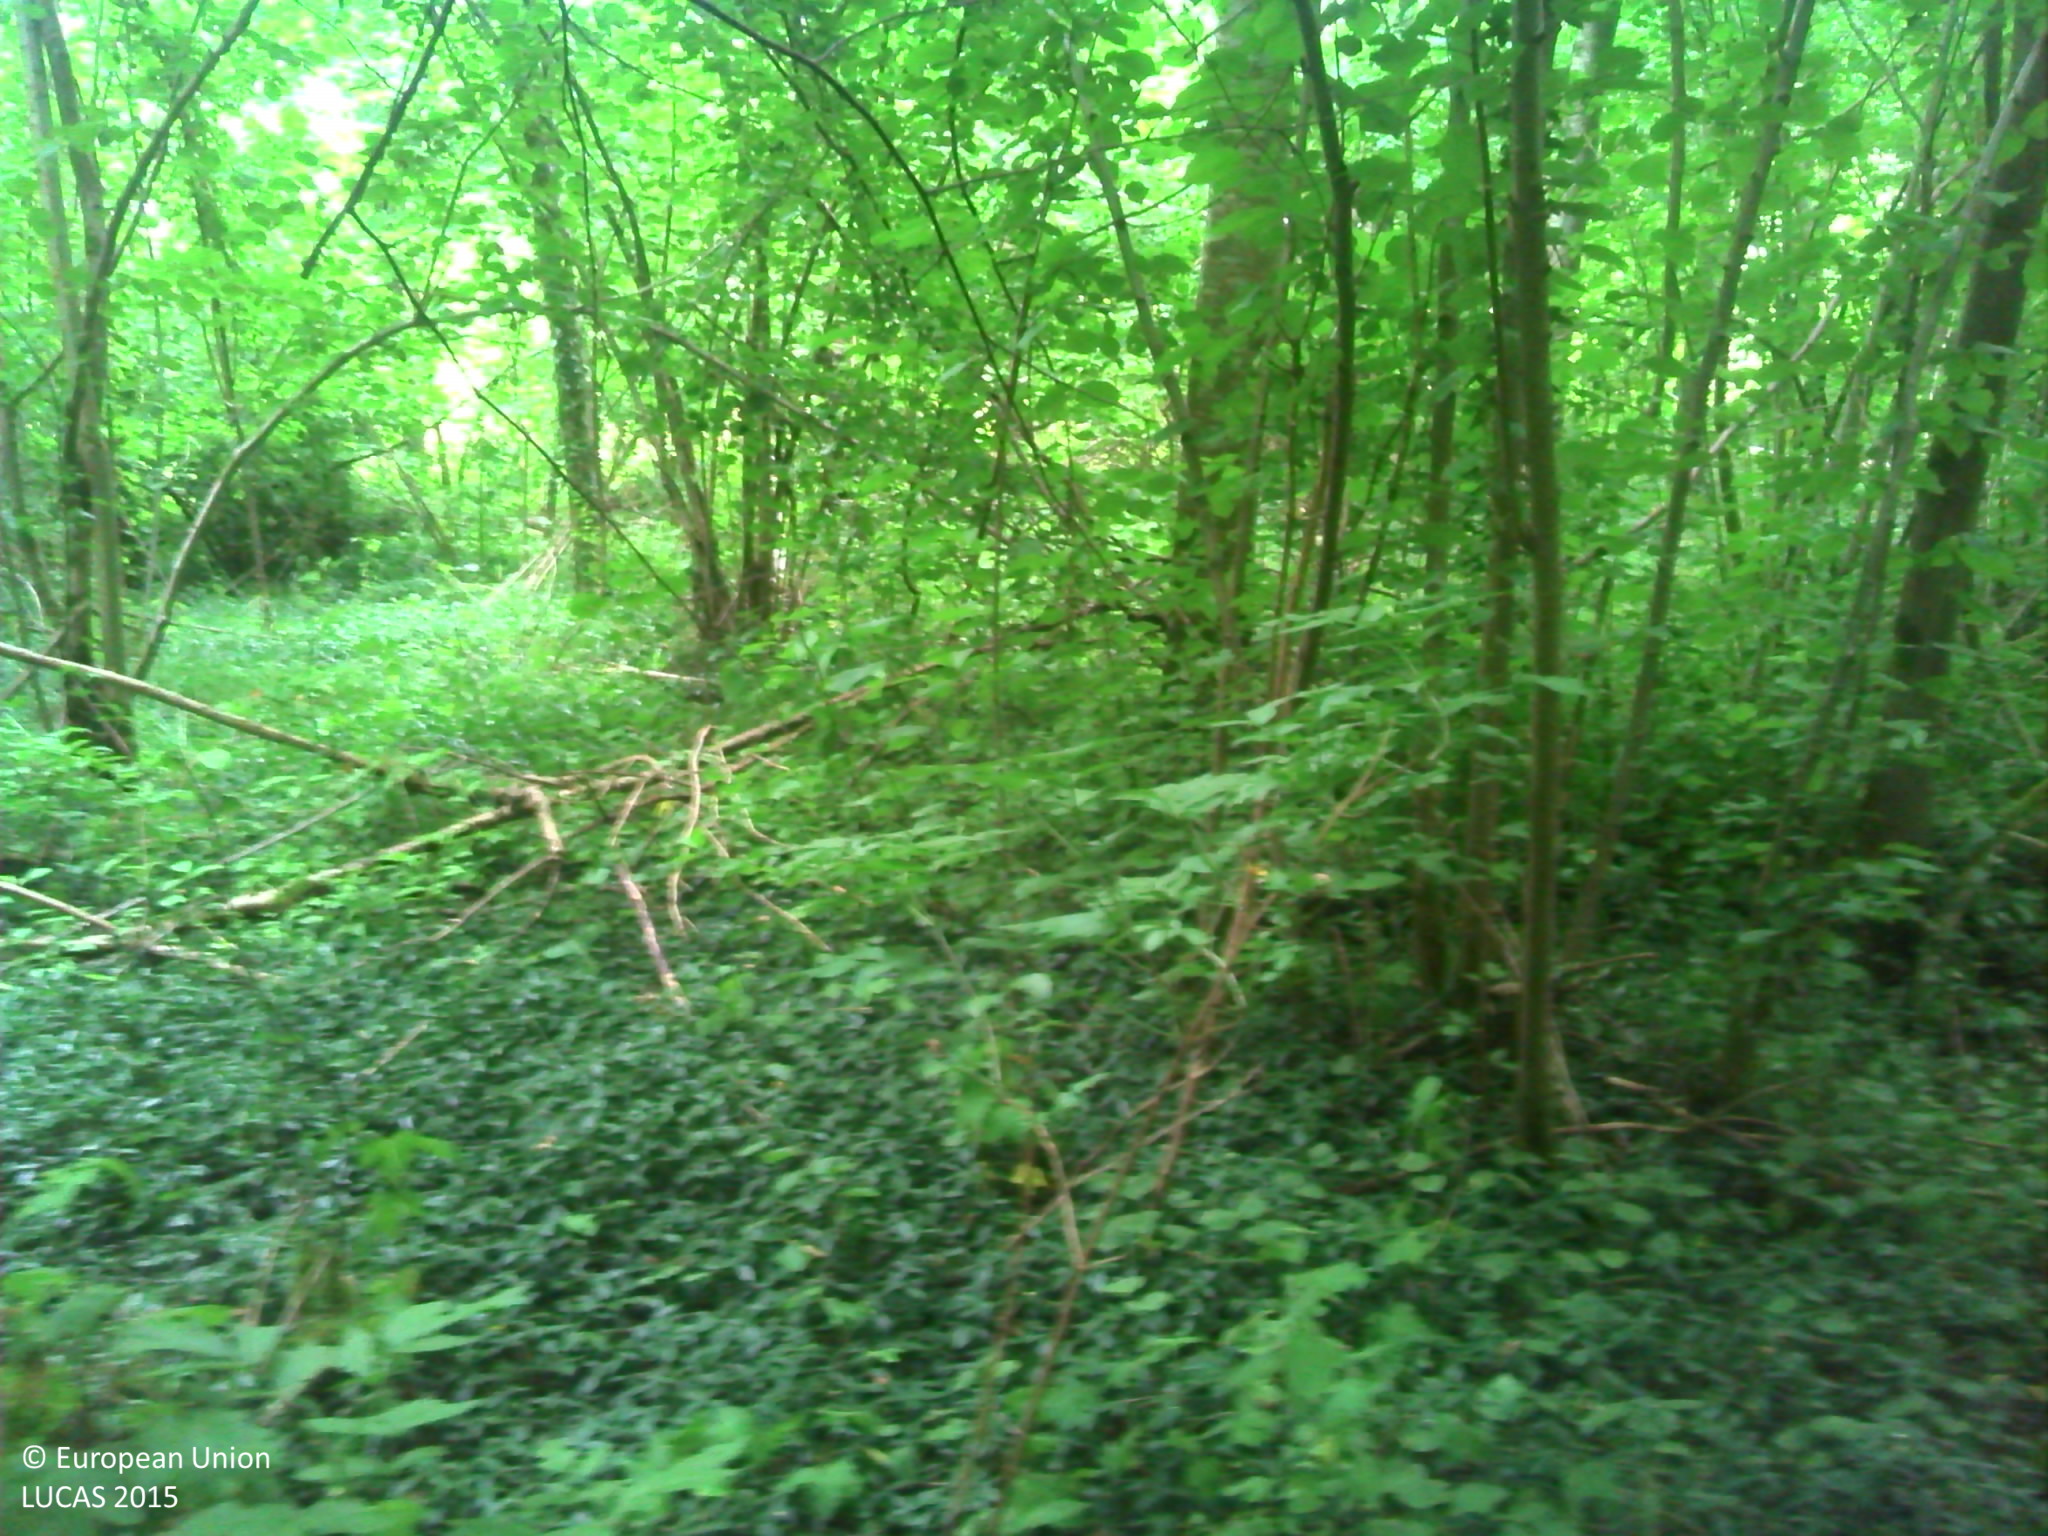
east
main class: Woodland
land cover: Broadleaved woodland
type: beech forest
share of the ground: > 75 %
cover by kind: broadleaved forest trees 90 %, herbaceous plants 10 %
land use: Forestry
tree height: > 5 m
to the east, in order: Broadleaved woodland; Tracks; Broadleaved woodland; Tracks; Broadleaved woodland
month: July
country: FR
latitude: 49.3548
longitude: 3.2874
